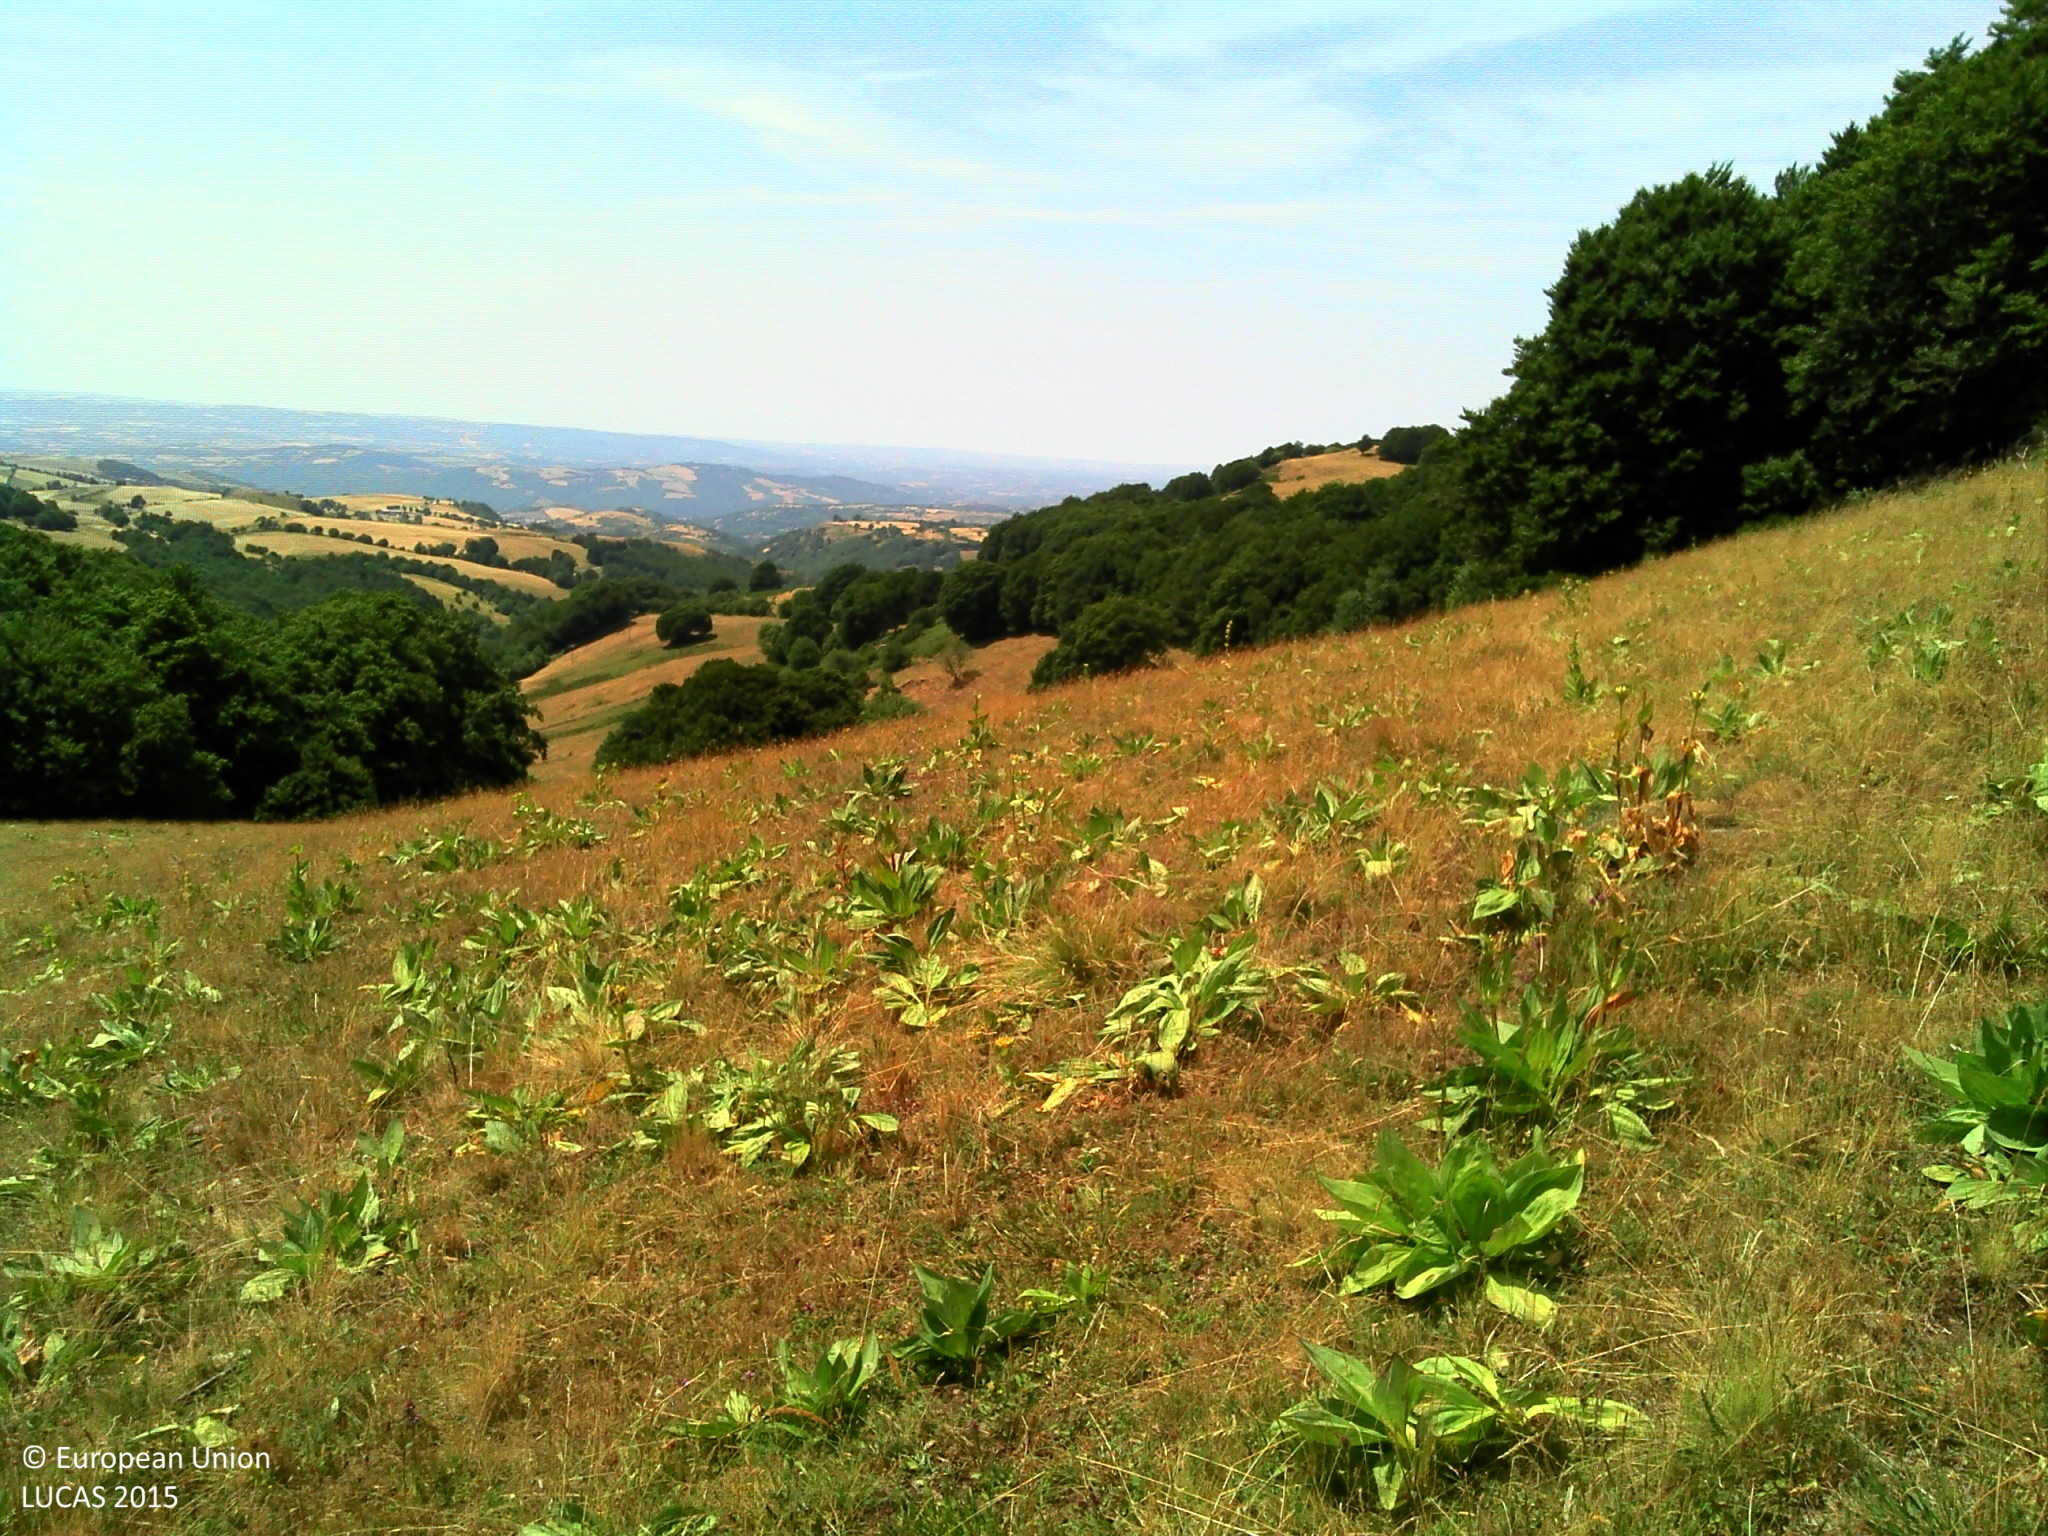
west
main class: Grassland
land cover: Grassland without tree/shrub cover
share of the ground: > 75 %
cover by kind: herbaceous plants 95 %, shrubs 5 %
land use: Agriculture (excluding fallow land and kitchen gardens)
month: July
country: FR
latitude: 44.5692
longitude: 3.0406
